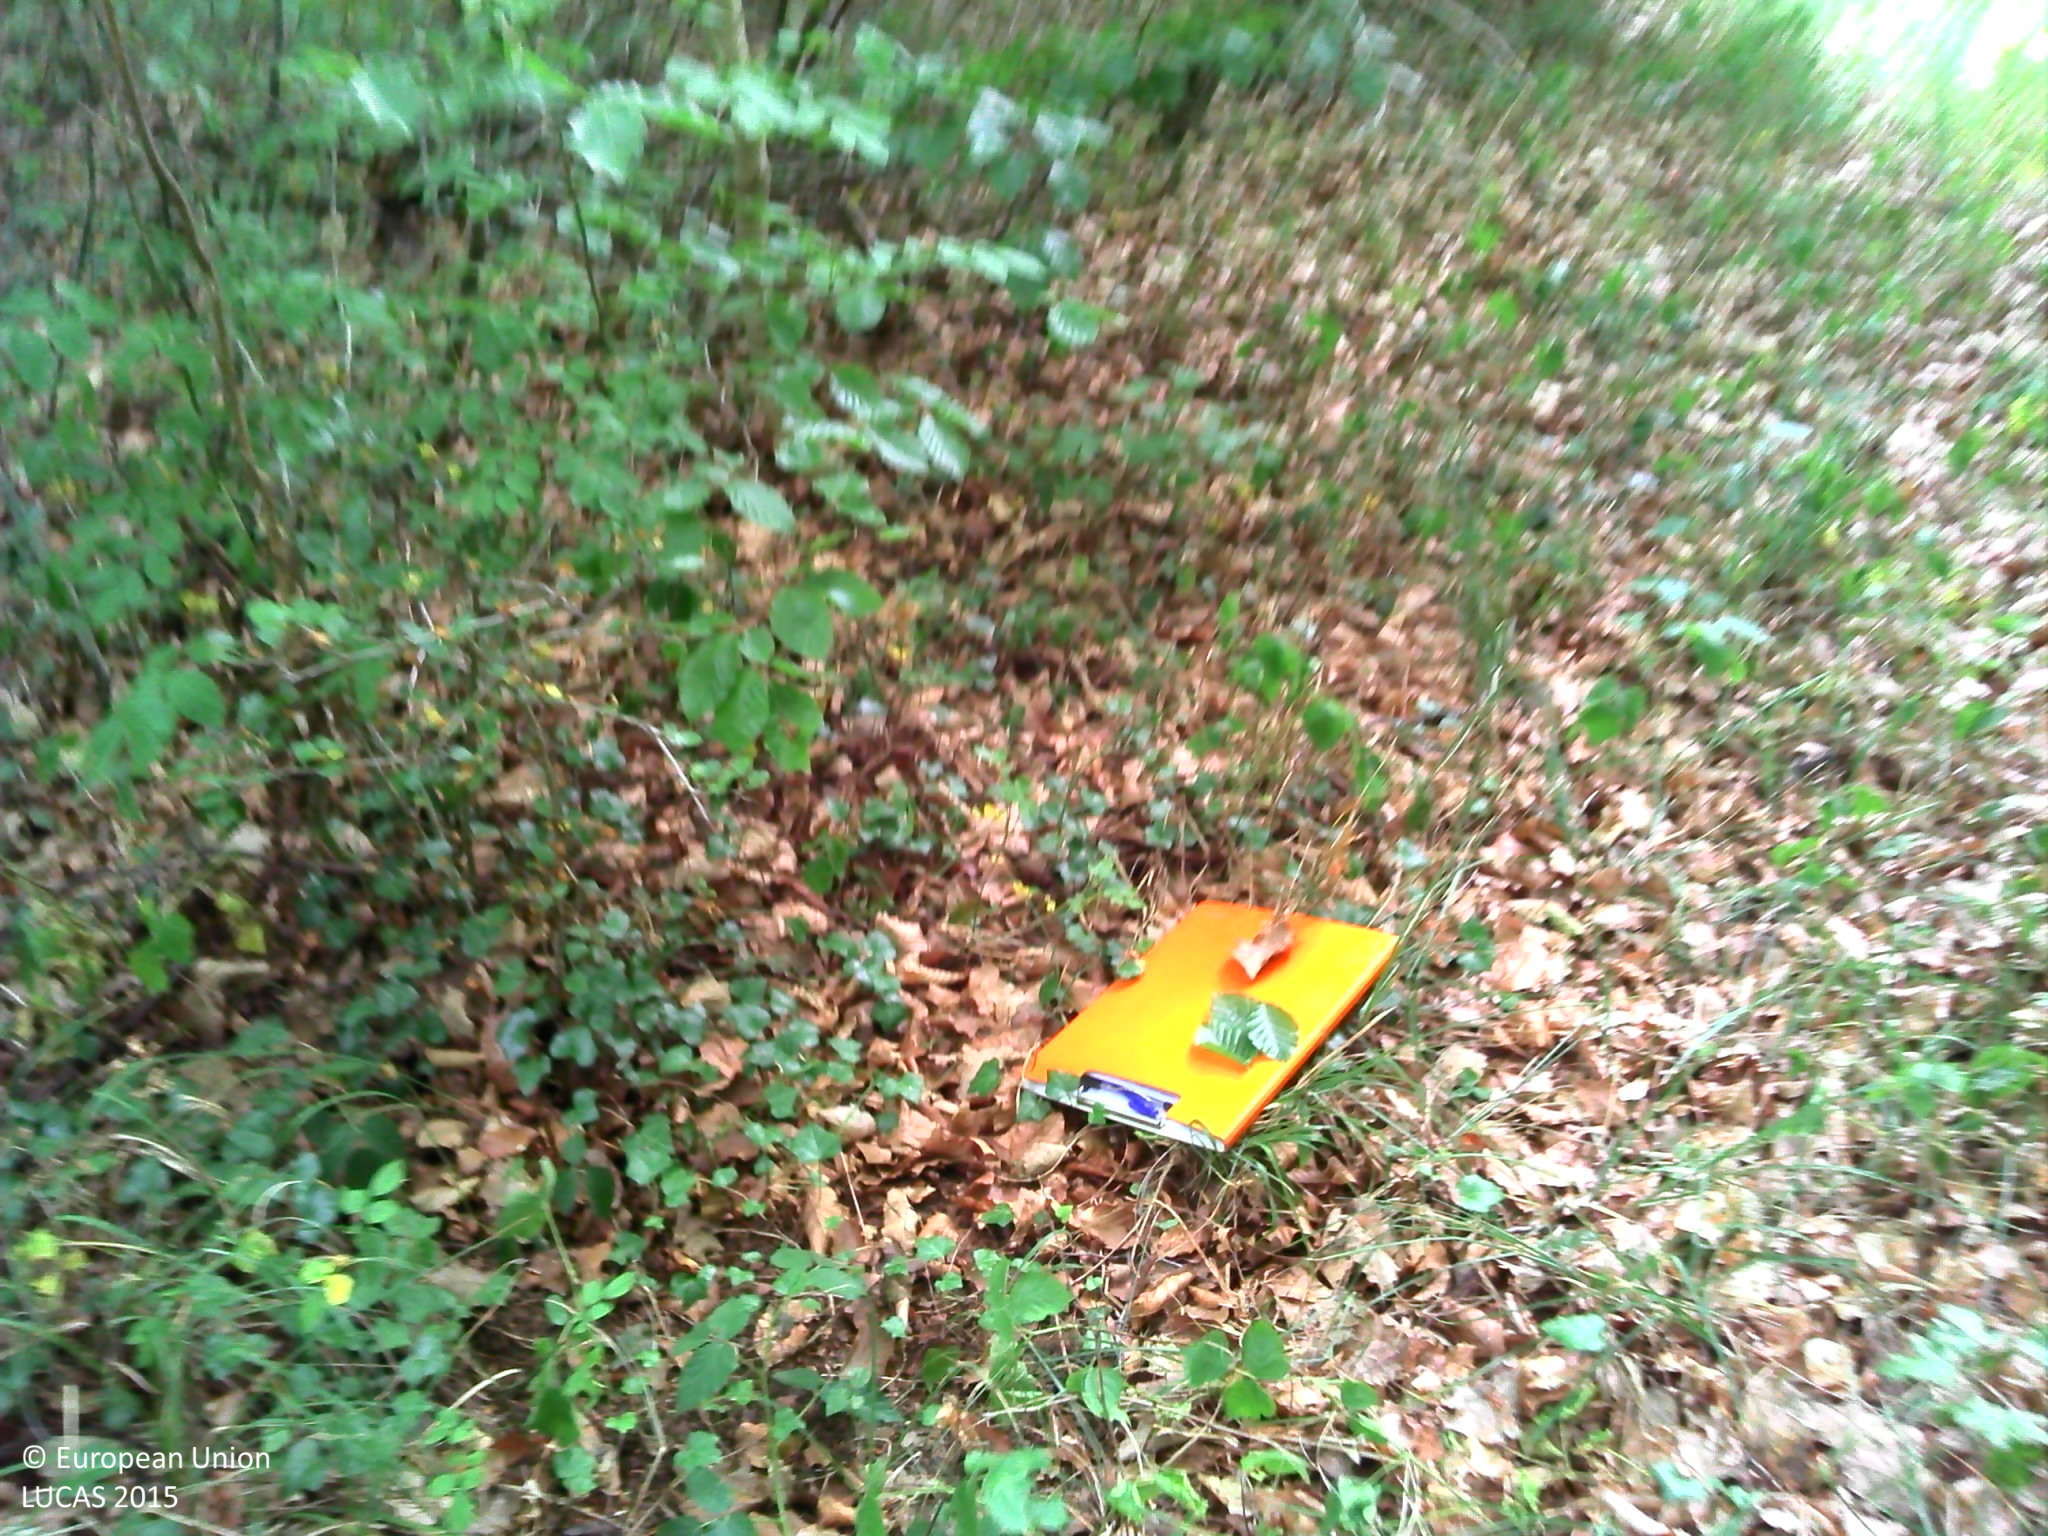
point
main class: Woodland
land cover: Broadleaved woodland
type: beech forest
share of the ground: > 75 %
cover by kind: broadleaved forest trees 80 %, herbaceous plants 10 %, shrubs 5 %, lichens and mosses 5 %
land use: Forestry
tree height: > 5 m
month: July
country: FR
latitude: 47.8296
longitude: 5.1773
